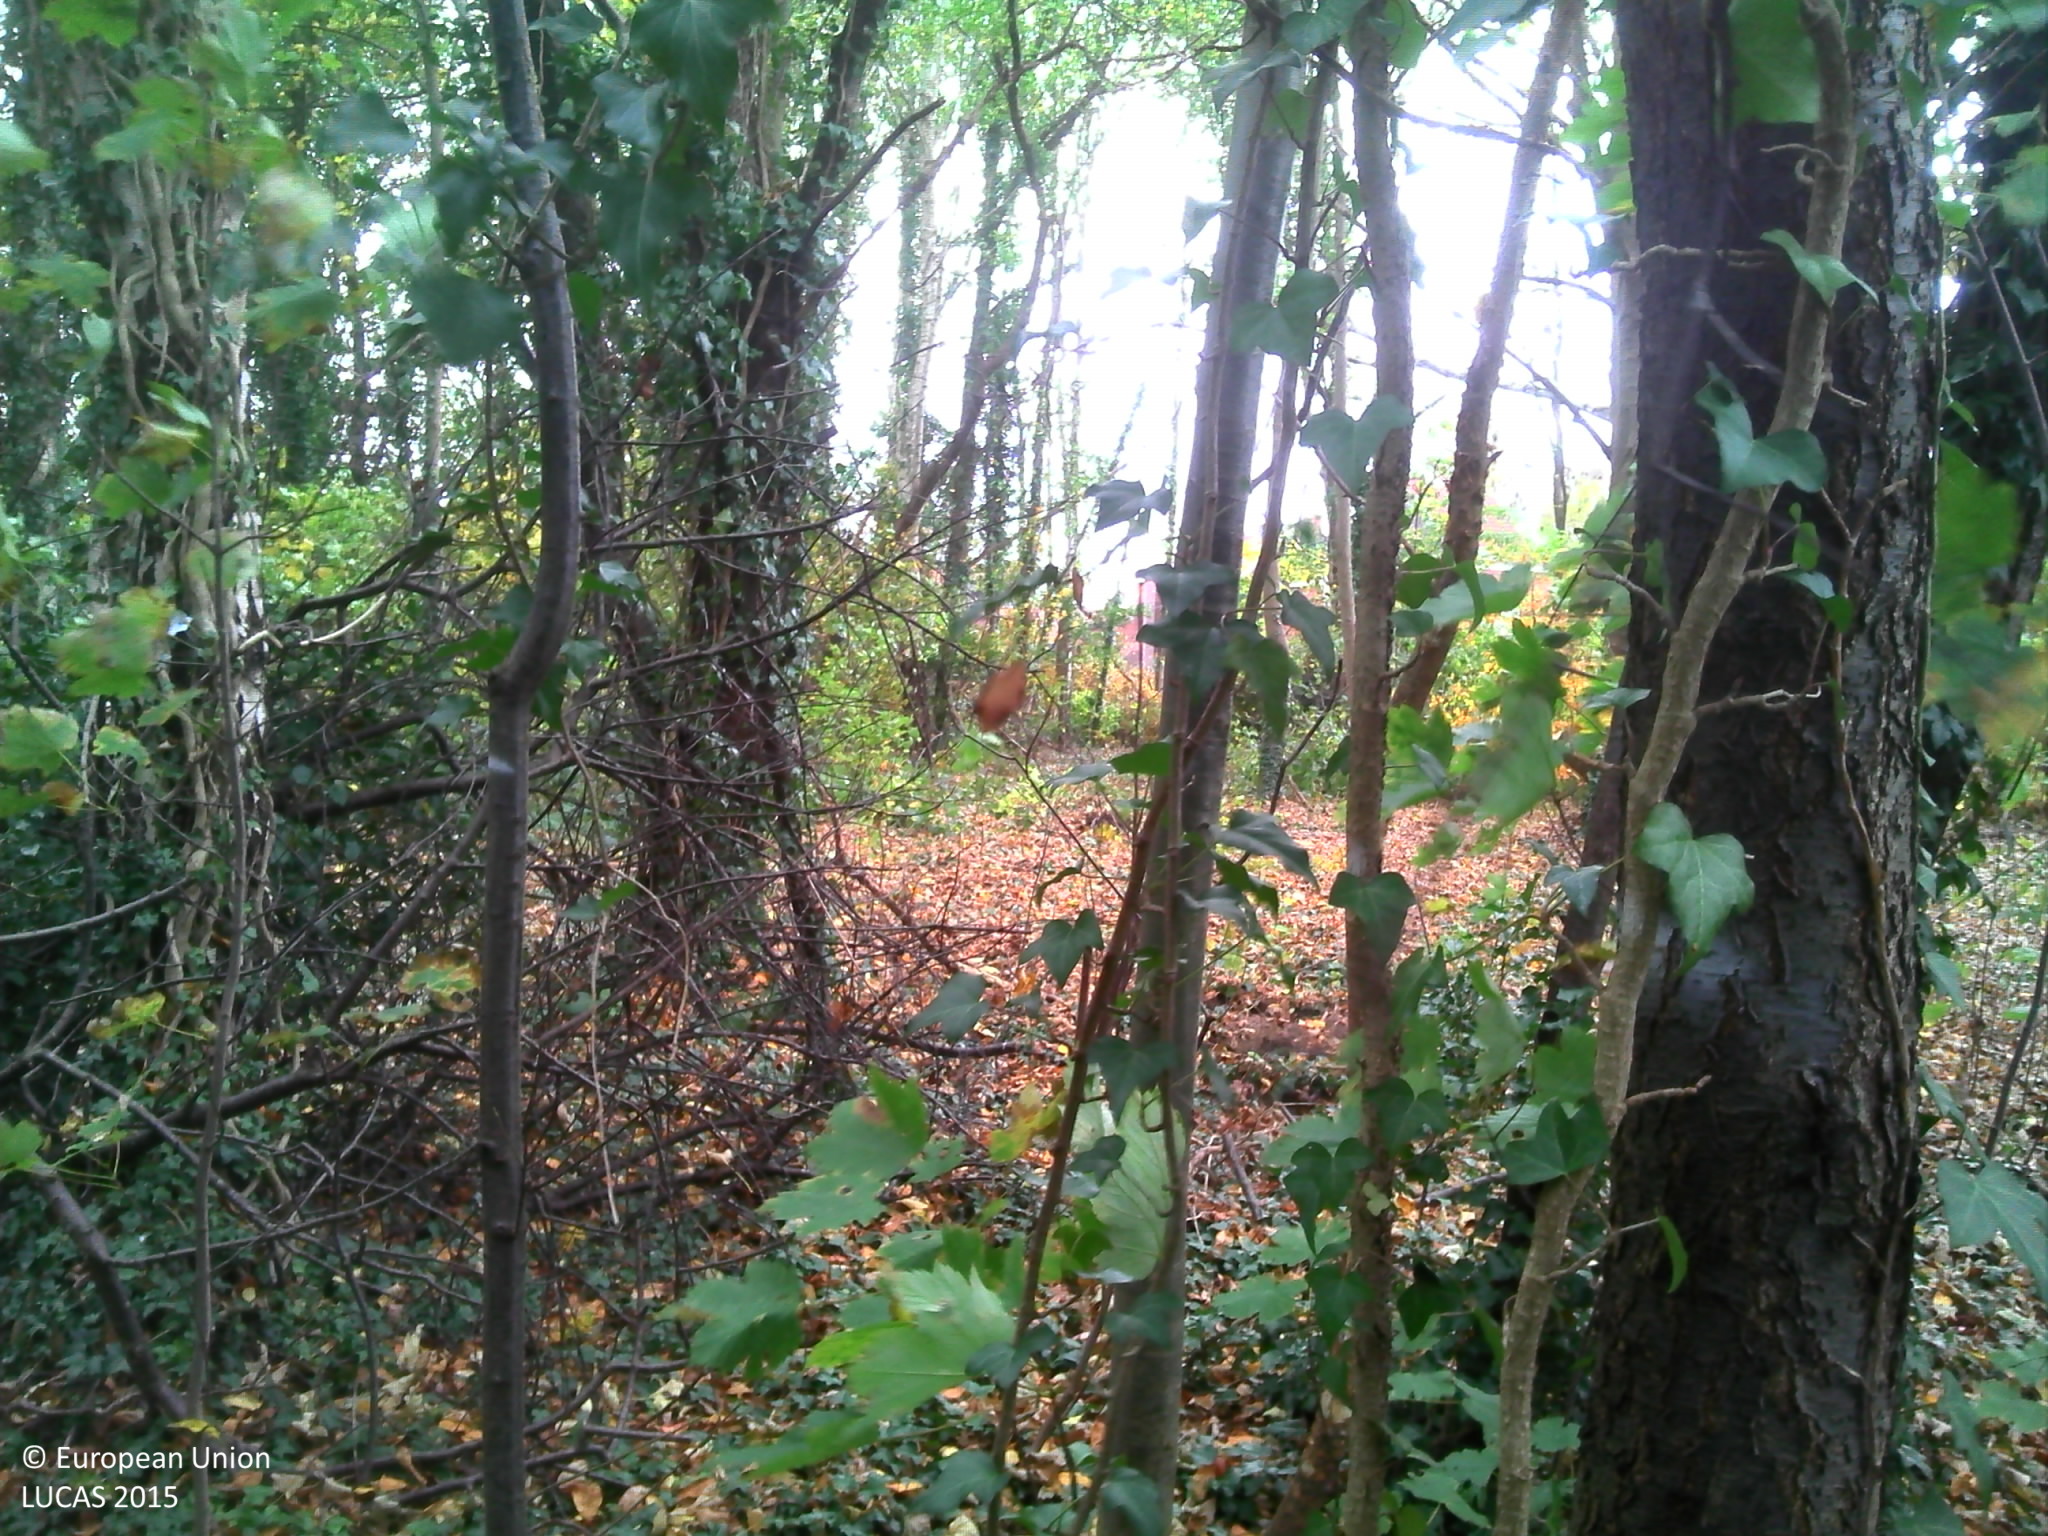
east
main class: Woodland
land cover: Broadleaved woodland
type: mesophytic deciduous forest
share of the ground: > 75 %
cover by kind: broadleaved forest trees 95 %, herbaceous plants 5 %
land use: Forestry
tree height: > 5 m
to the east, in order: Broadleaved woodland; Other bare soil; Artificial constructions in urban areas
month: November
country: BE
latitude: 51.0071
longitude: 4.5088
